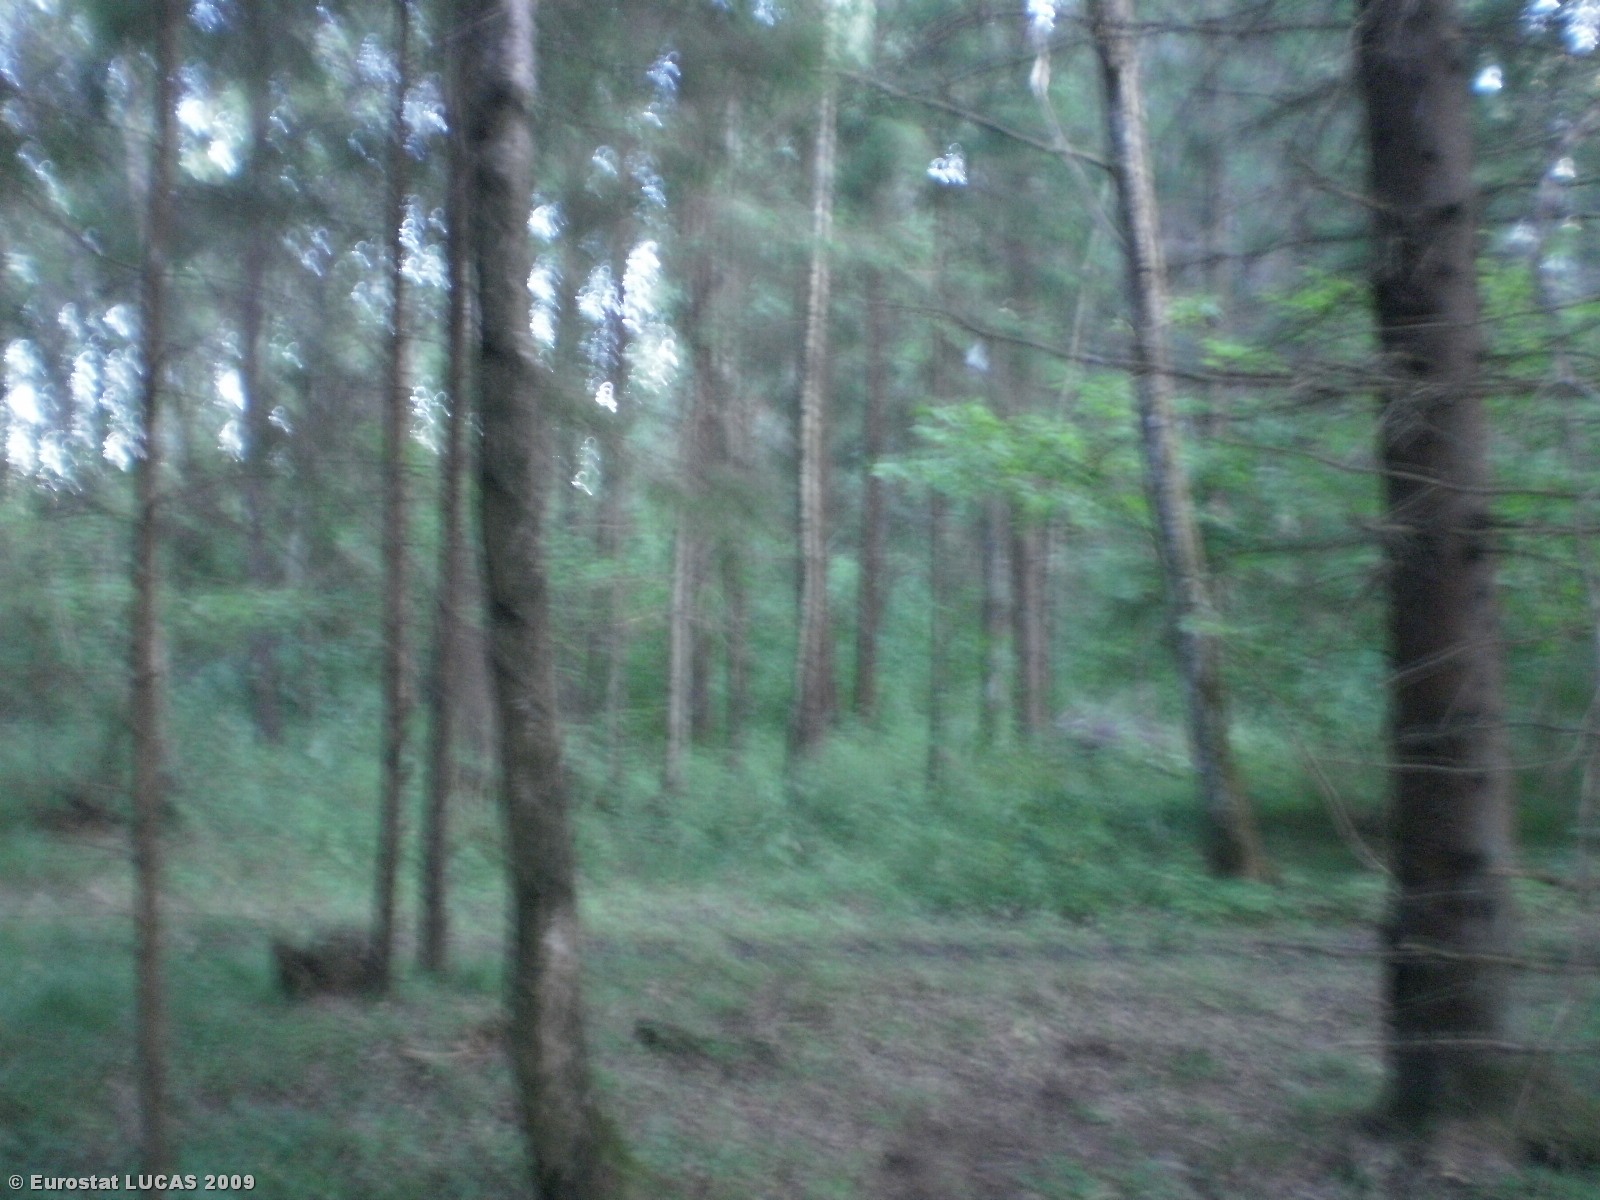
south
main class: Woodland
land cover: Coniferous woodland
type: boreal forest
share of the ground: 25 - 50 %
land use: Forestry
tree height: > 5 m
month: July
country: LT
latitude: 55.9083
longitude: 25.2658
